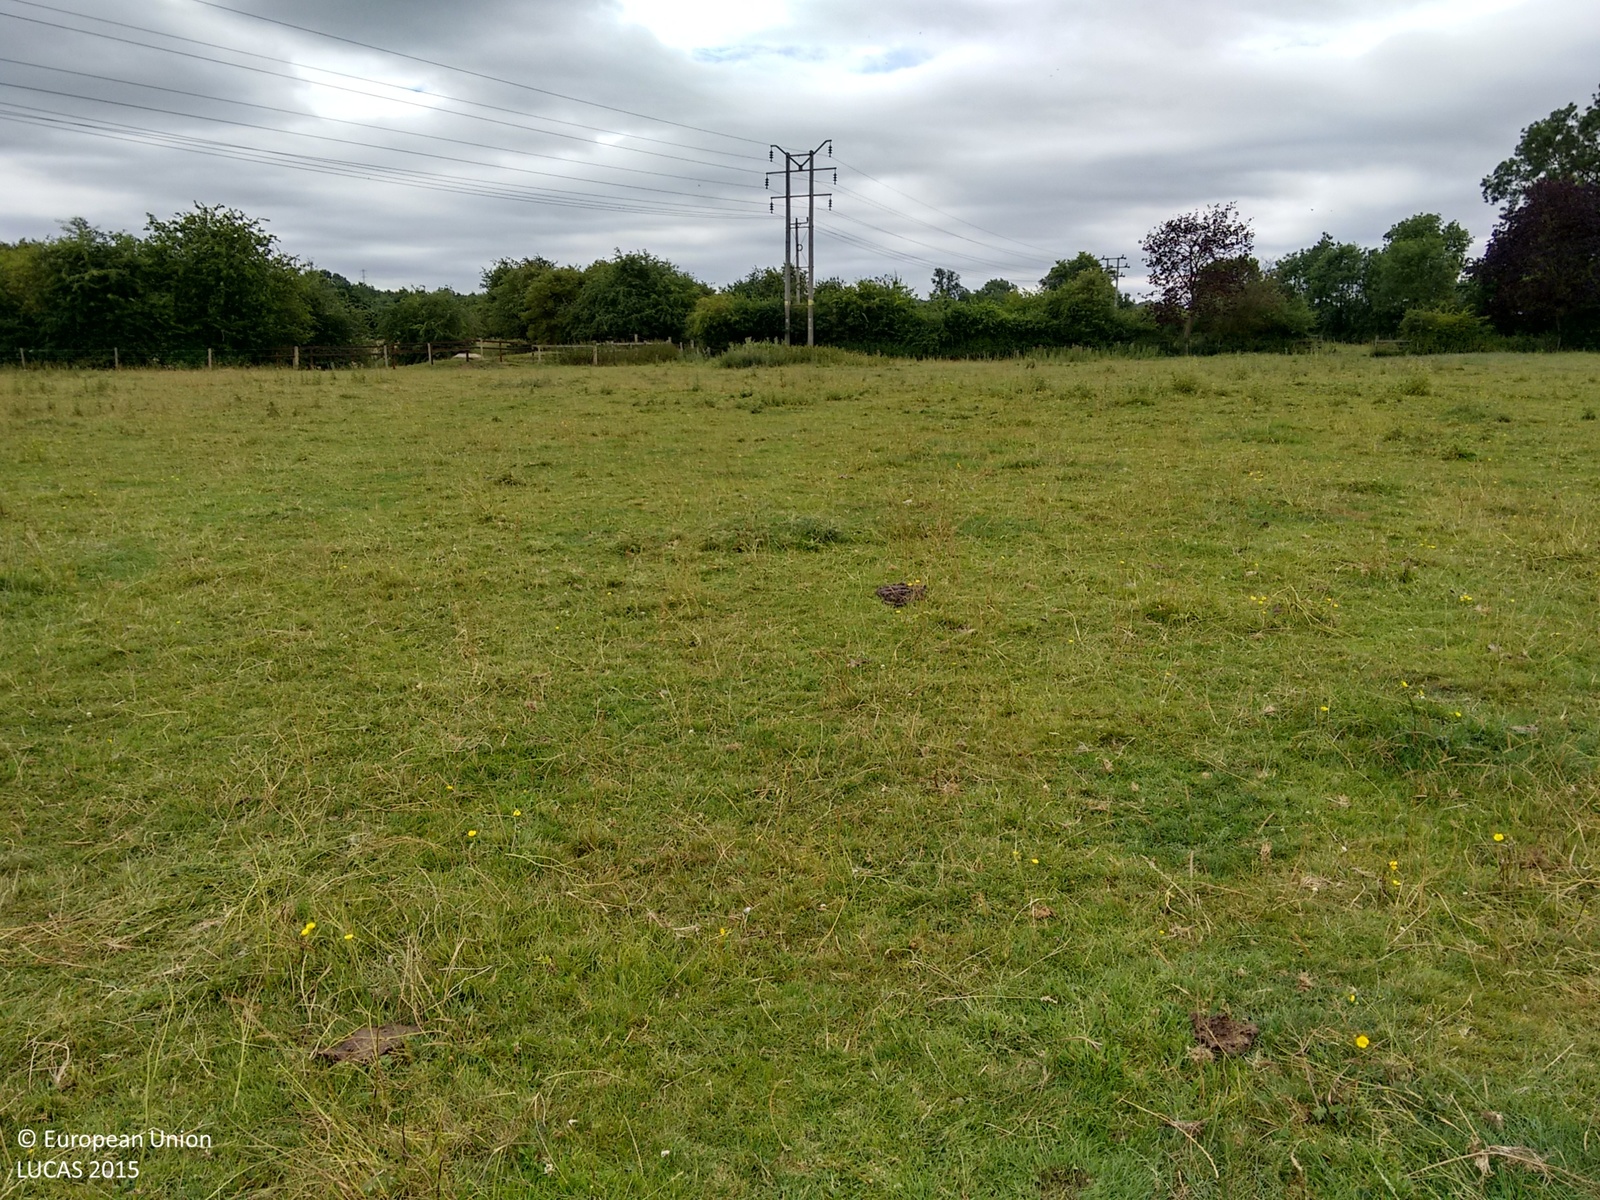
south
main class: Grassland
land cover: Grassland without tree/shrub cover
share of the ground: > 75 %
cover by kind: herbaceous plants 100 %
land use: Agriculture (excluding fallow land and kitchen gardens)
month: July
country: GB
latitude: 52.4912
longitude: -0.8973
